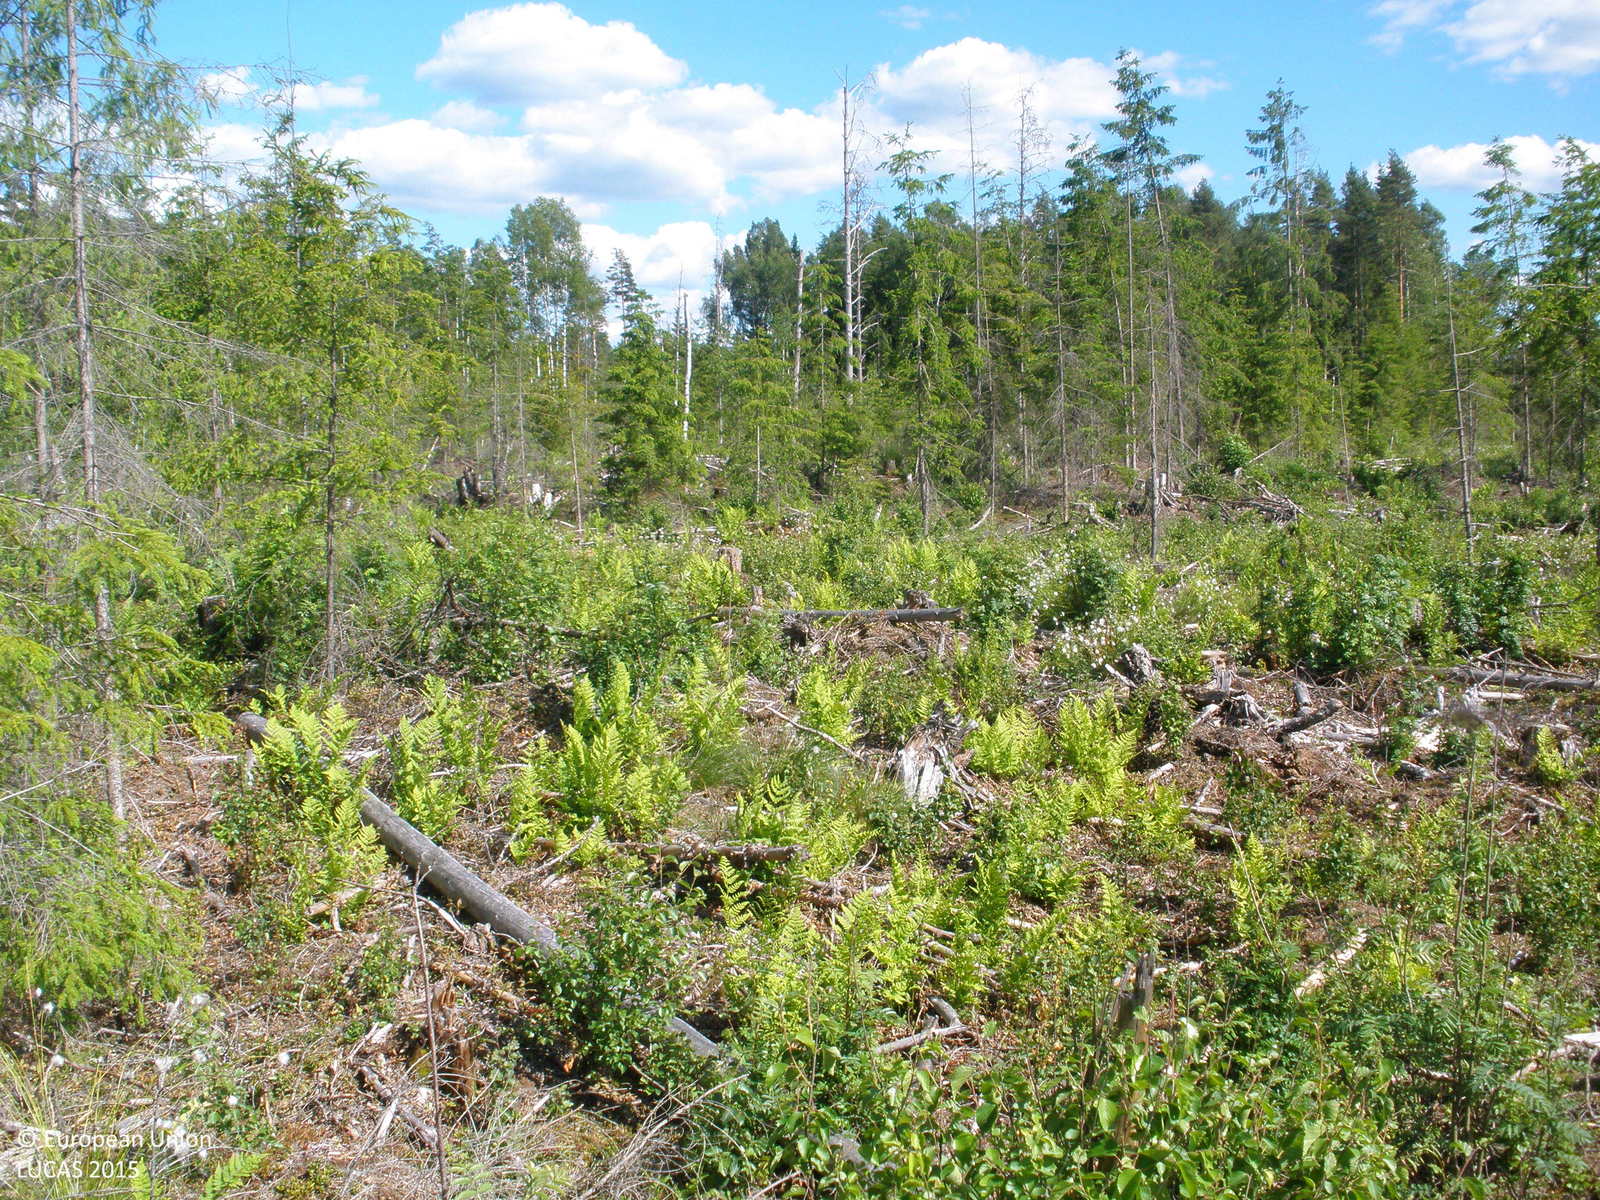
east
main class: Woodland
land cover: Spruce dominated mixed woodland
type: boreal forest
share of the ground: 50 - 75 %
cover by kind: coniferous forest trees 25 %, broadleaved forest trees 25 %, unconsolidated bare surface 25 %, herbaceous plants 10 %, consolidated bare surface 10 %
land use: Forestry
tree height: < 5 m
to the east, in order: Spruce dominated mixed woodland; Ditches and canals; Other bare soil; Ditches and canals; Broadleaved woodland; Ditches and canals; Other bare soil; Ditches and canals; Spruce dominated mixed woodland; Ditches and canals; Other bare soil; Pine dominated mixed woodland; Spruce dominated mixed woodland; Ditches and canals; Spruce dominated mixed woodland; Ditches and canals; Spruce dominated coniferous woodland
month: June
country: FI
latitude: 61.0628
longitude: 24.6493
